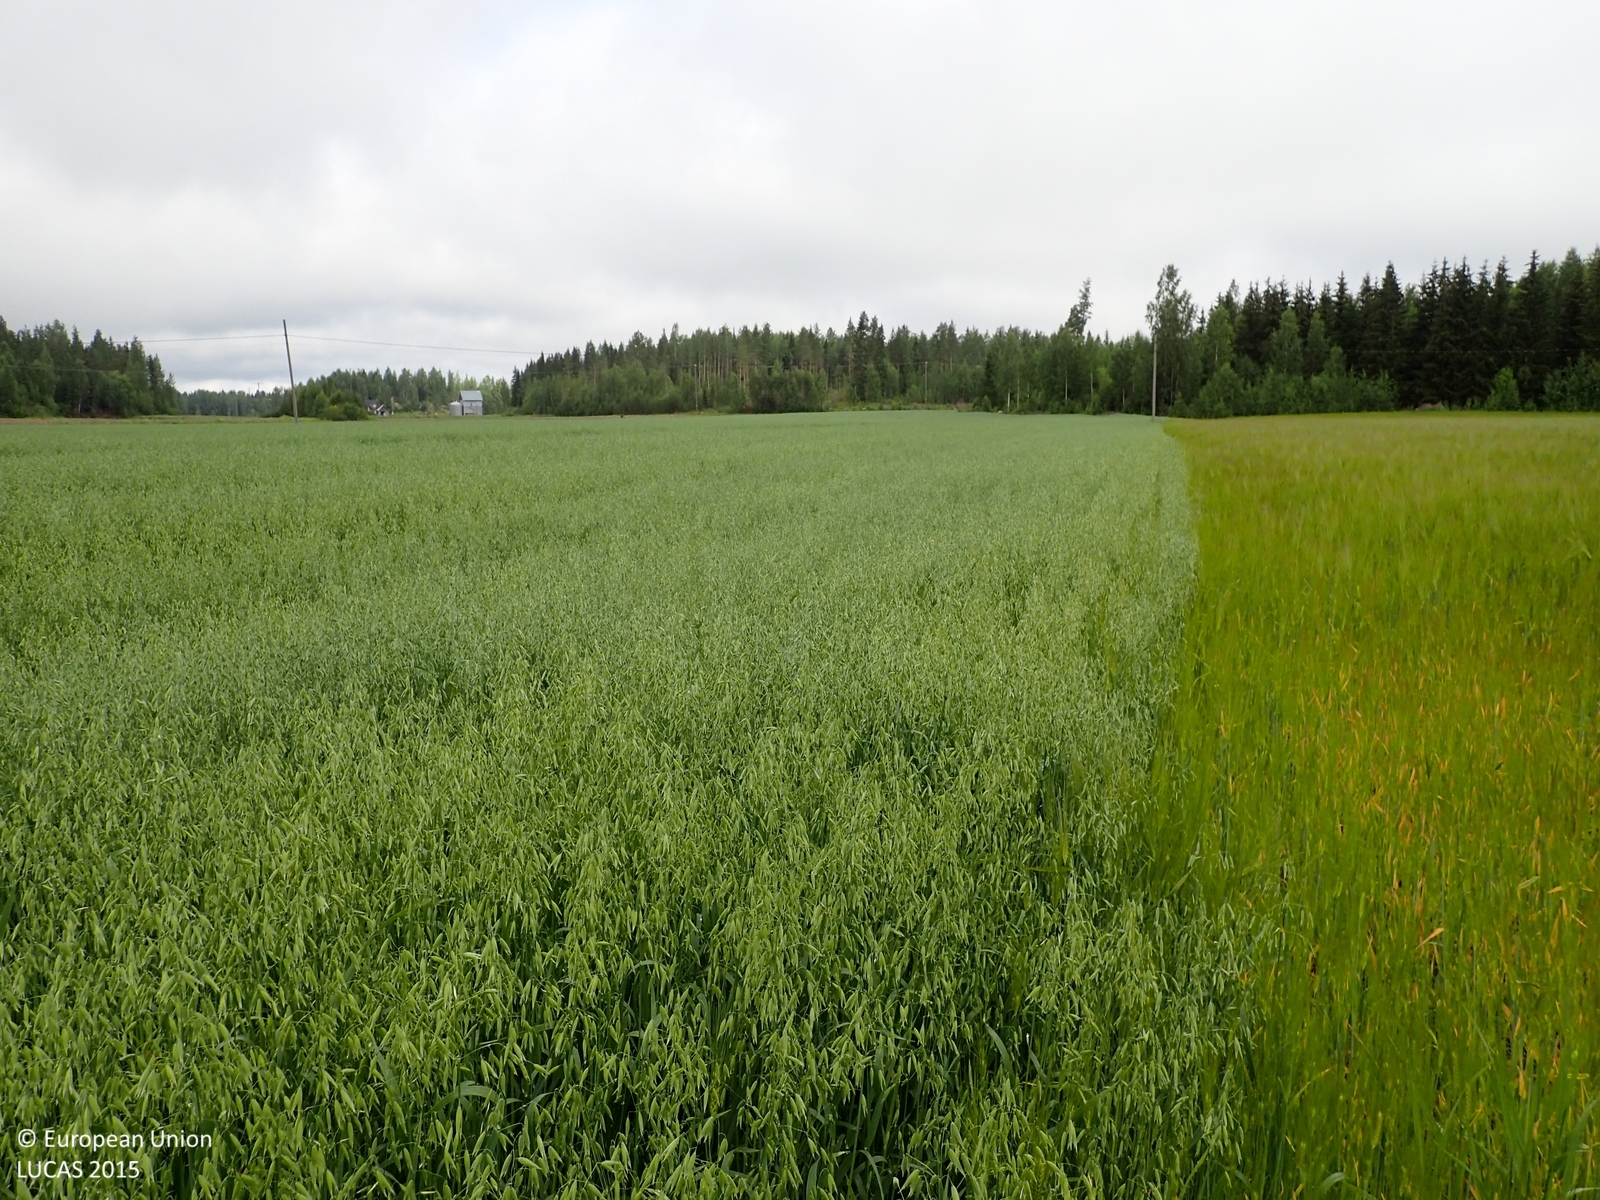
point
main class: Cropland
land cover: Oats
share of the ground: > 75 %
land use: Agriculture (excluding fallow land and kitchen gardens)
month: July
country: FI
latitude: 62.9679
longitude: 22.4964
